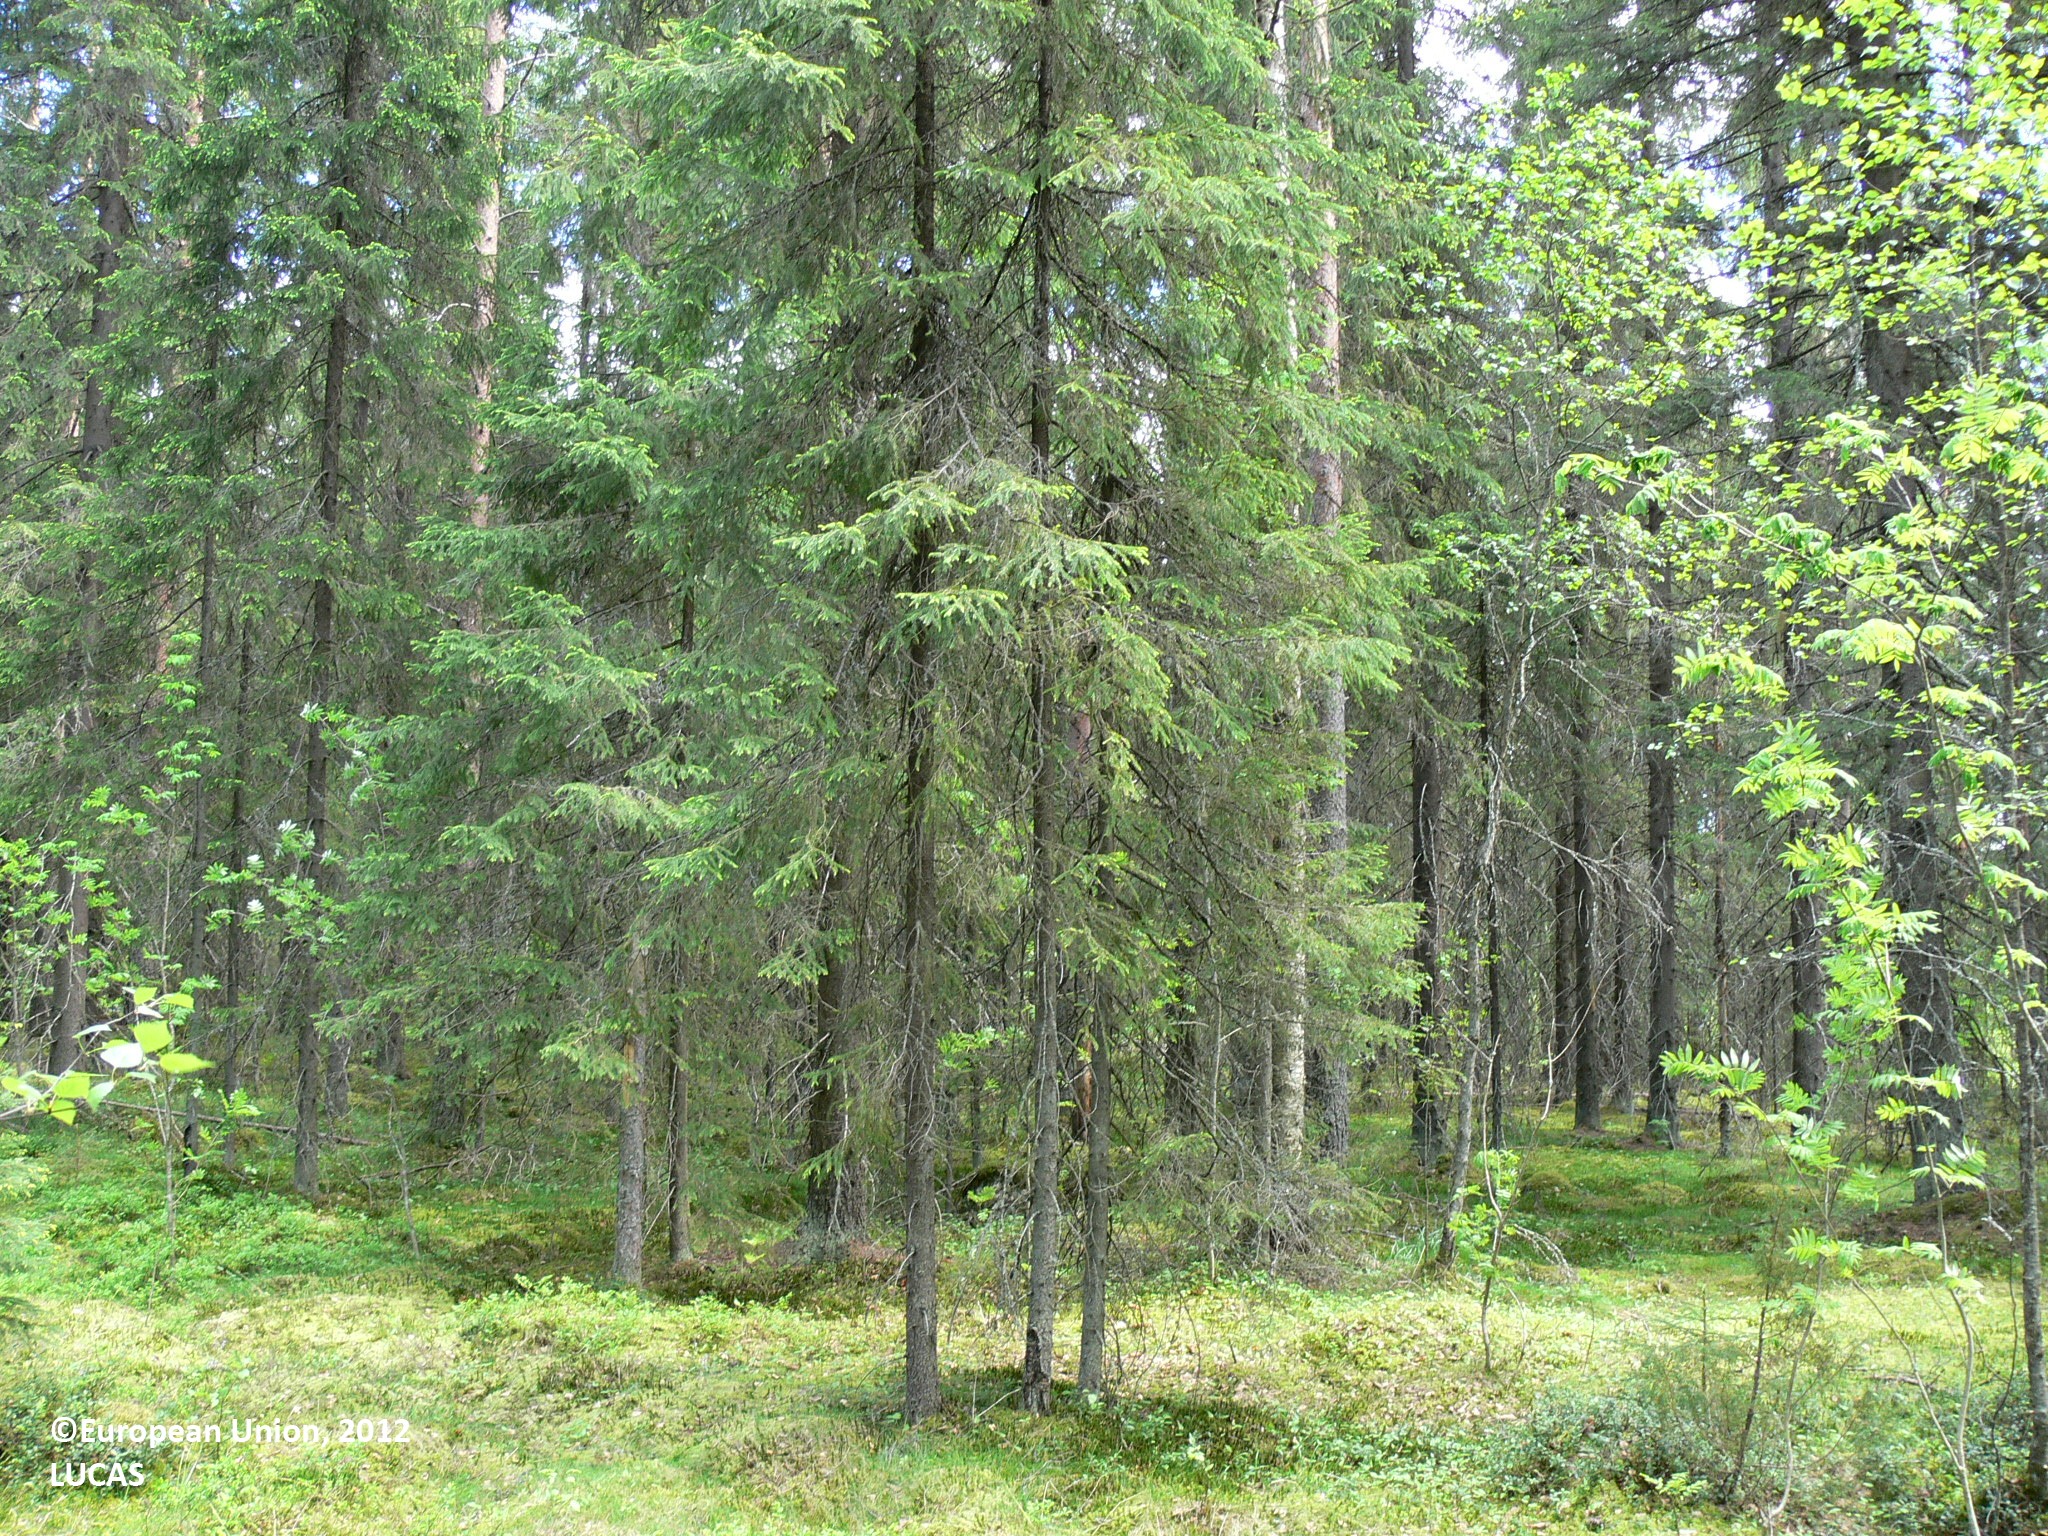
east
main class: Woodland
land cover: Spruce dominated coniferous woodland
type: boreal forest
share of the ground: > 75 %
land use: Forestry
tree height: > 5 m
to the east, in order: Spruce dominated coniferous woodland; Tracks; Spruce dominated coniferous woodland; Other mixed woodland; Spruce dominated mixed woodland
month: June
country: FI
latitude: 62.5658
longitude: 30.6180
